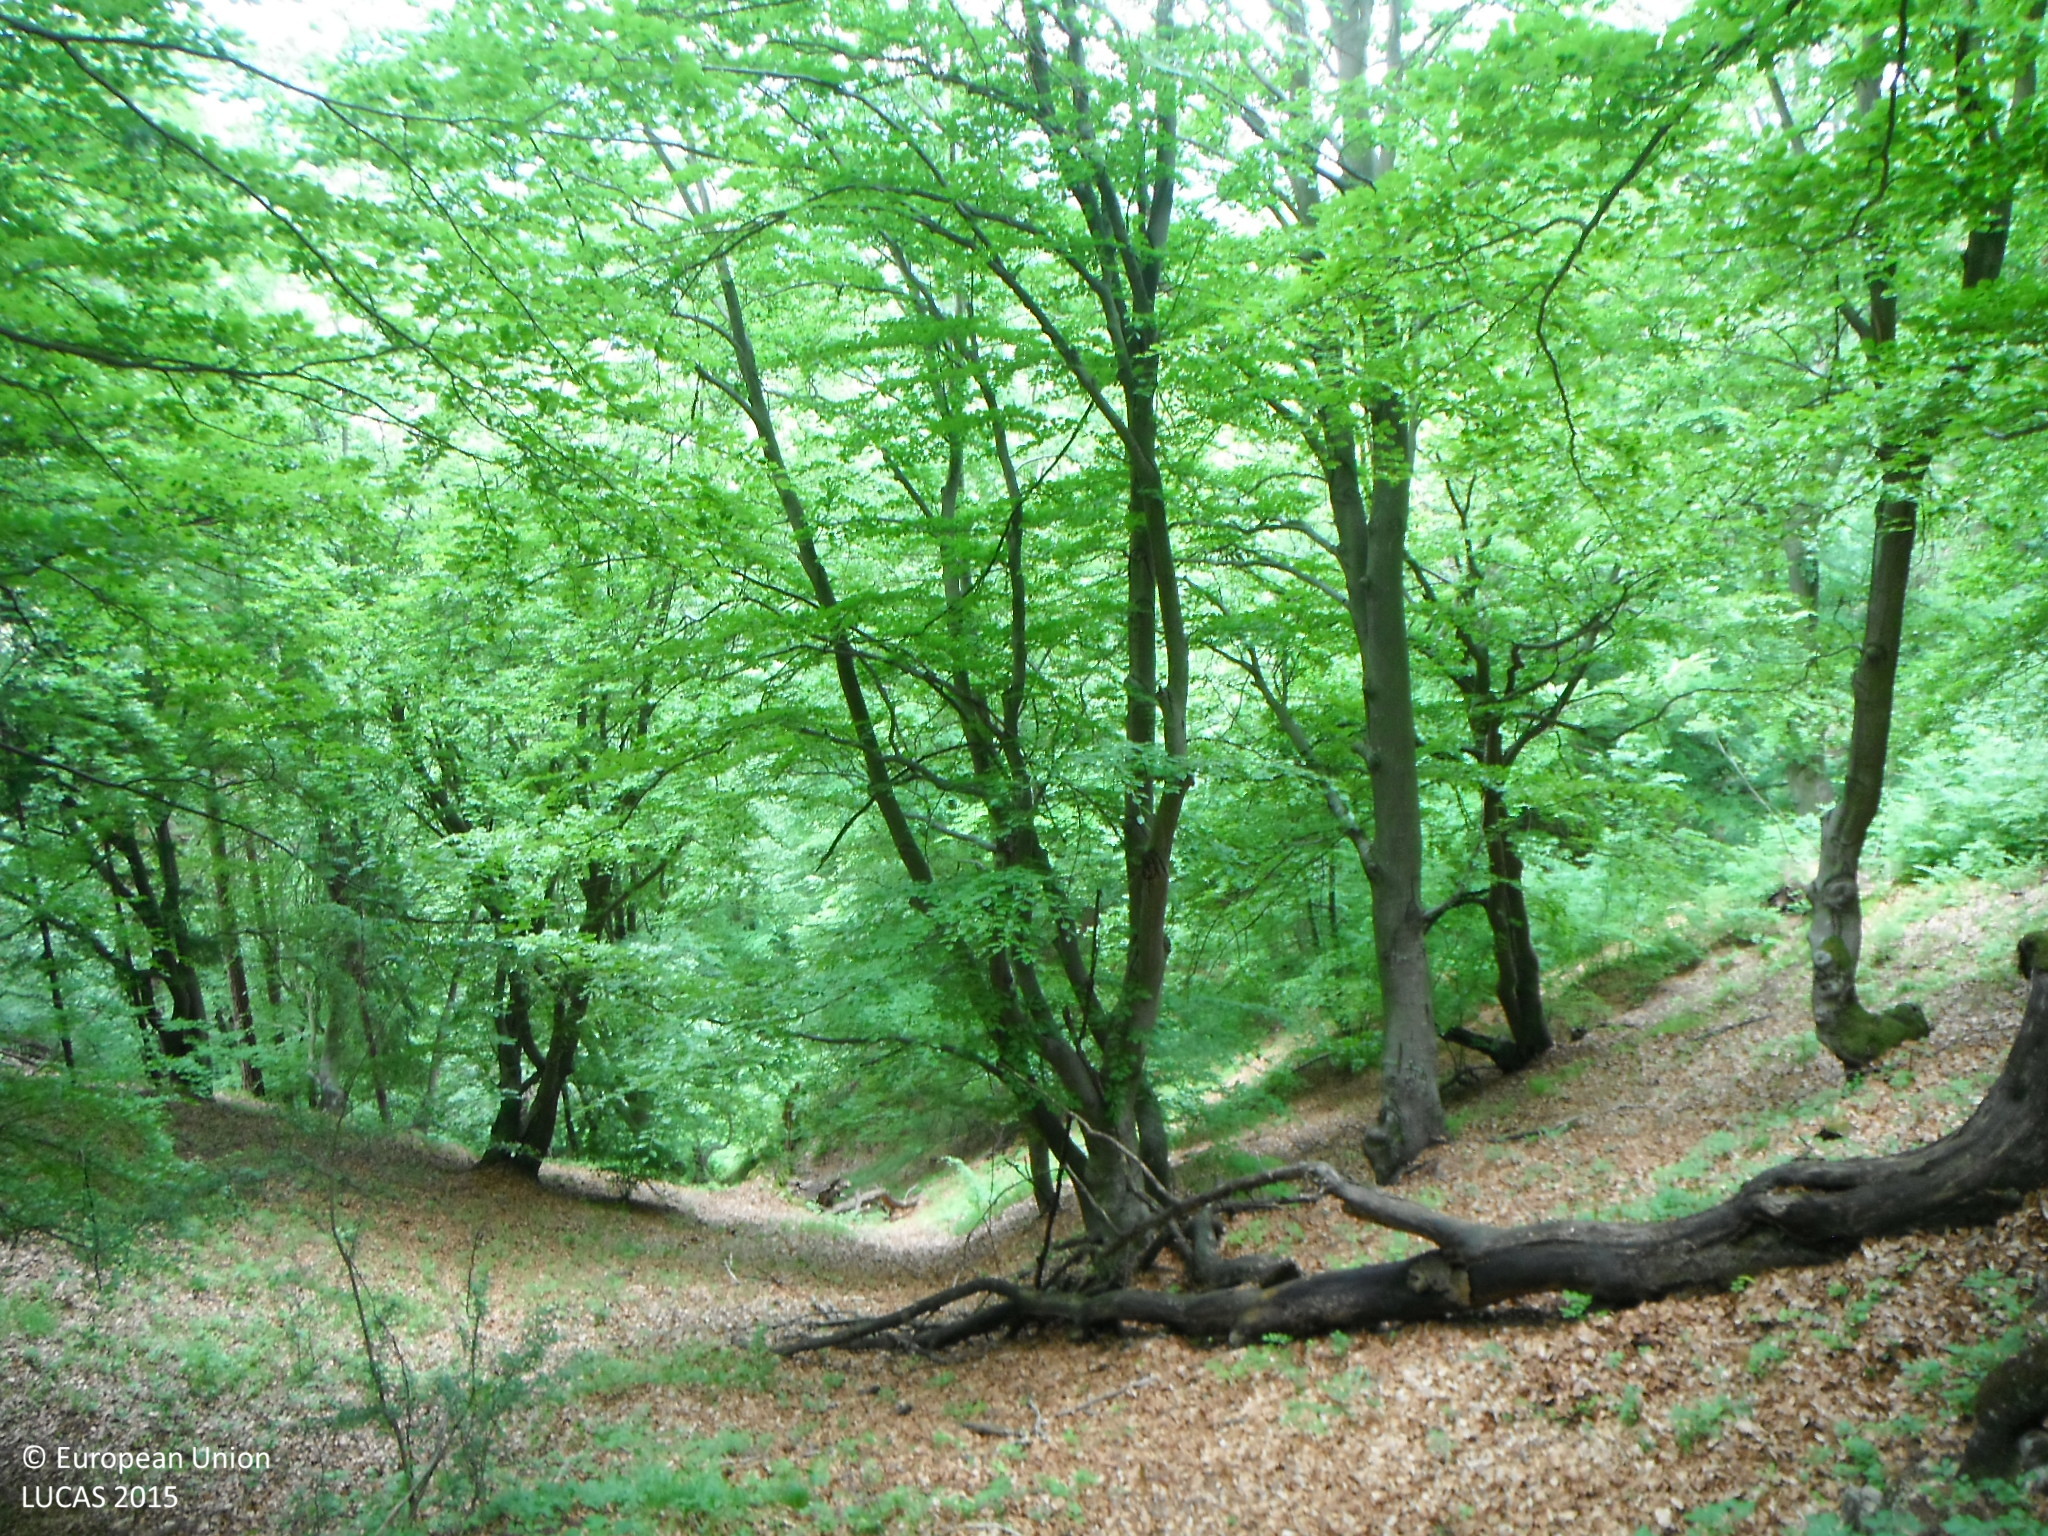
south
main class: Woodland
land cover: Broadleaved woodland
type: mountainous beech forest
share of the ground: > 75 %
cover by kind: broadleaved forest trees 100 %
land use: Forestry
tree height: > 5 m
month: June
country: SK
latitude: 48.8034
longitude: 19.3506
